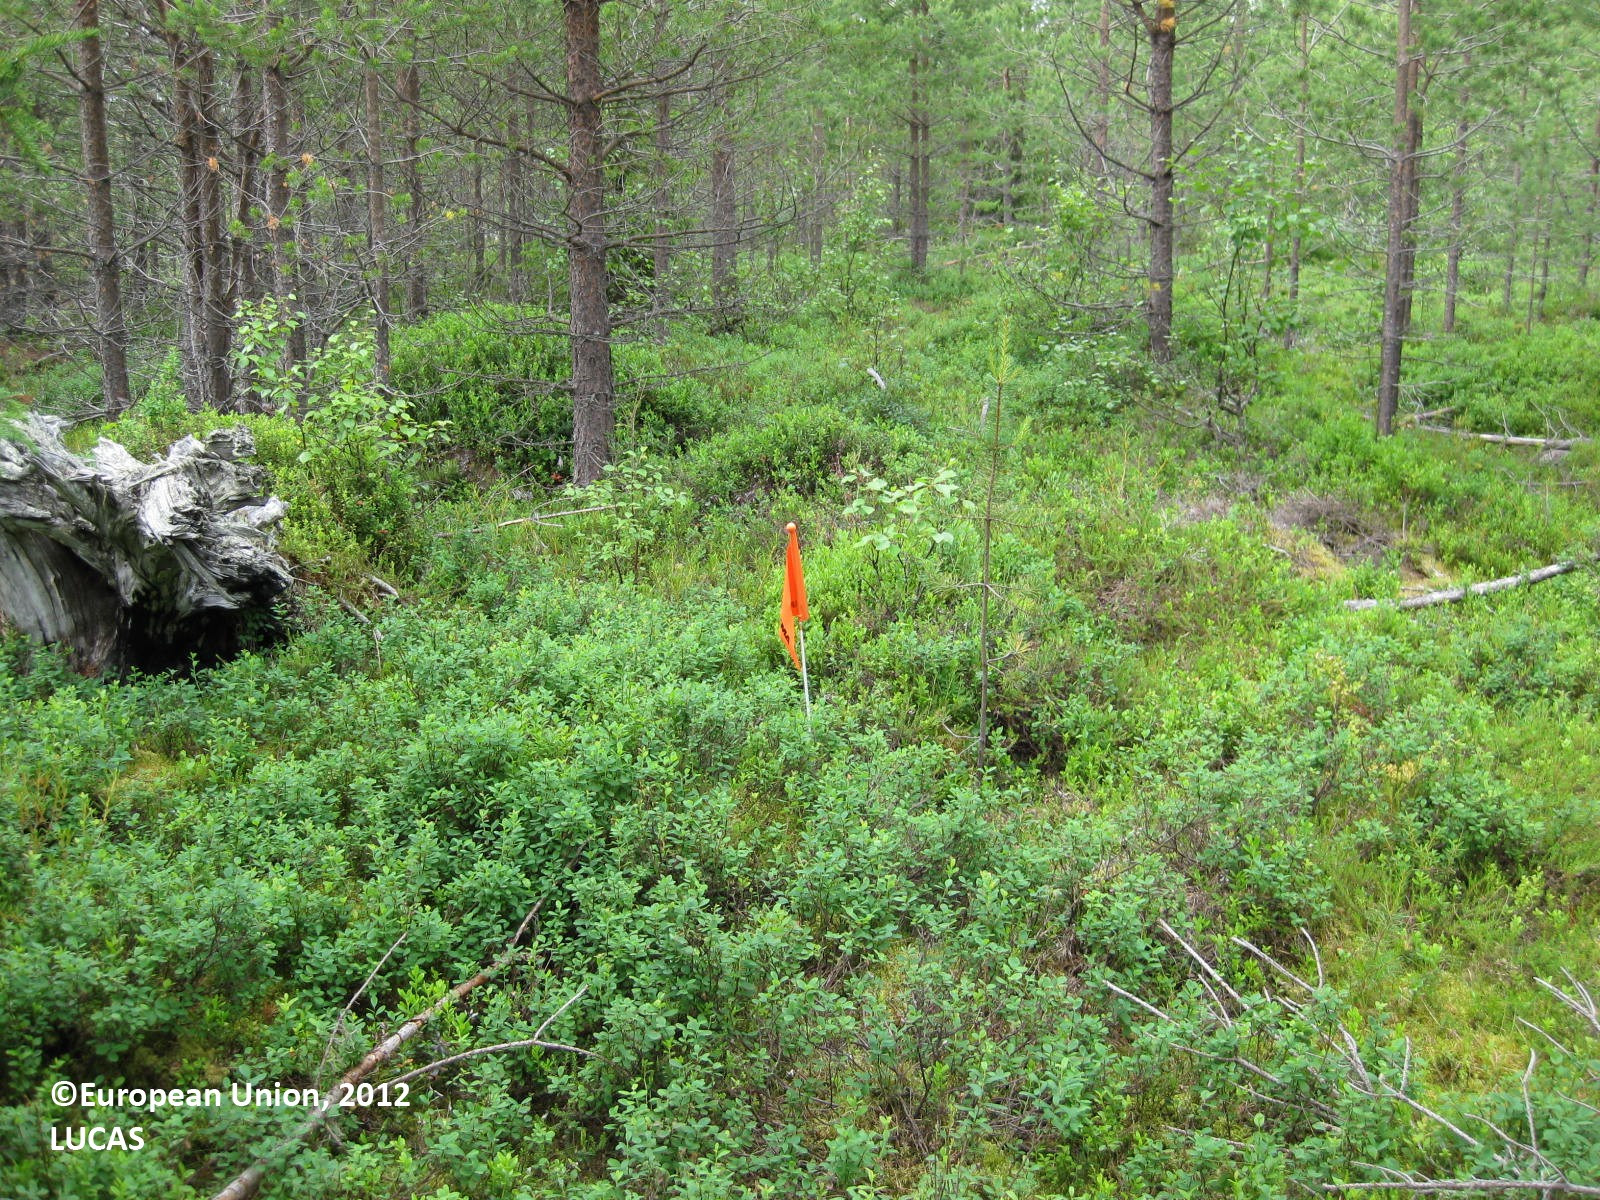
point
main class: Woodland
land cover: Pine dominated coniferous woodland
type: boreal forest
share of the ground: > 75 %
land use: Forestry
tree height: > 5 m
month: July
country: FI
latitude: 65.6555
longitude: 29.2529
